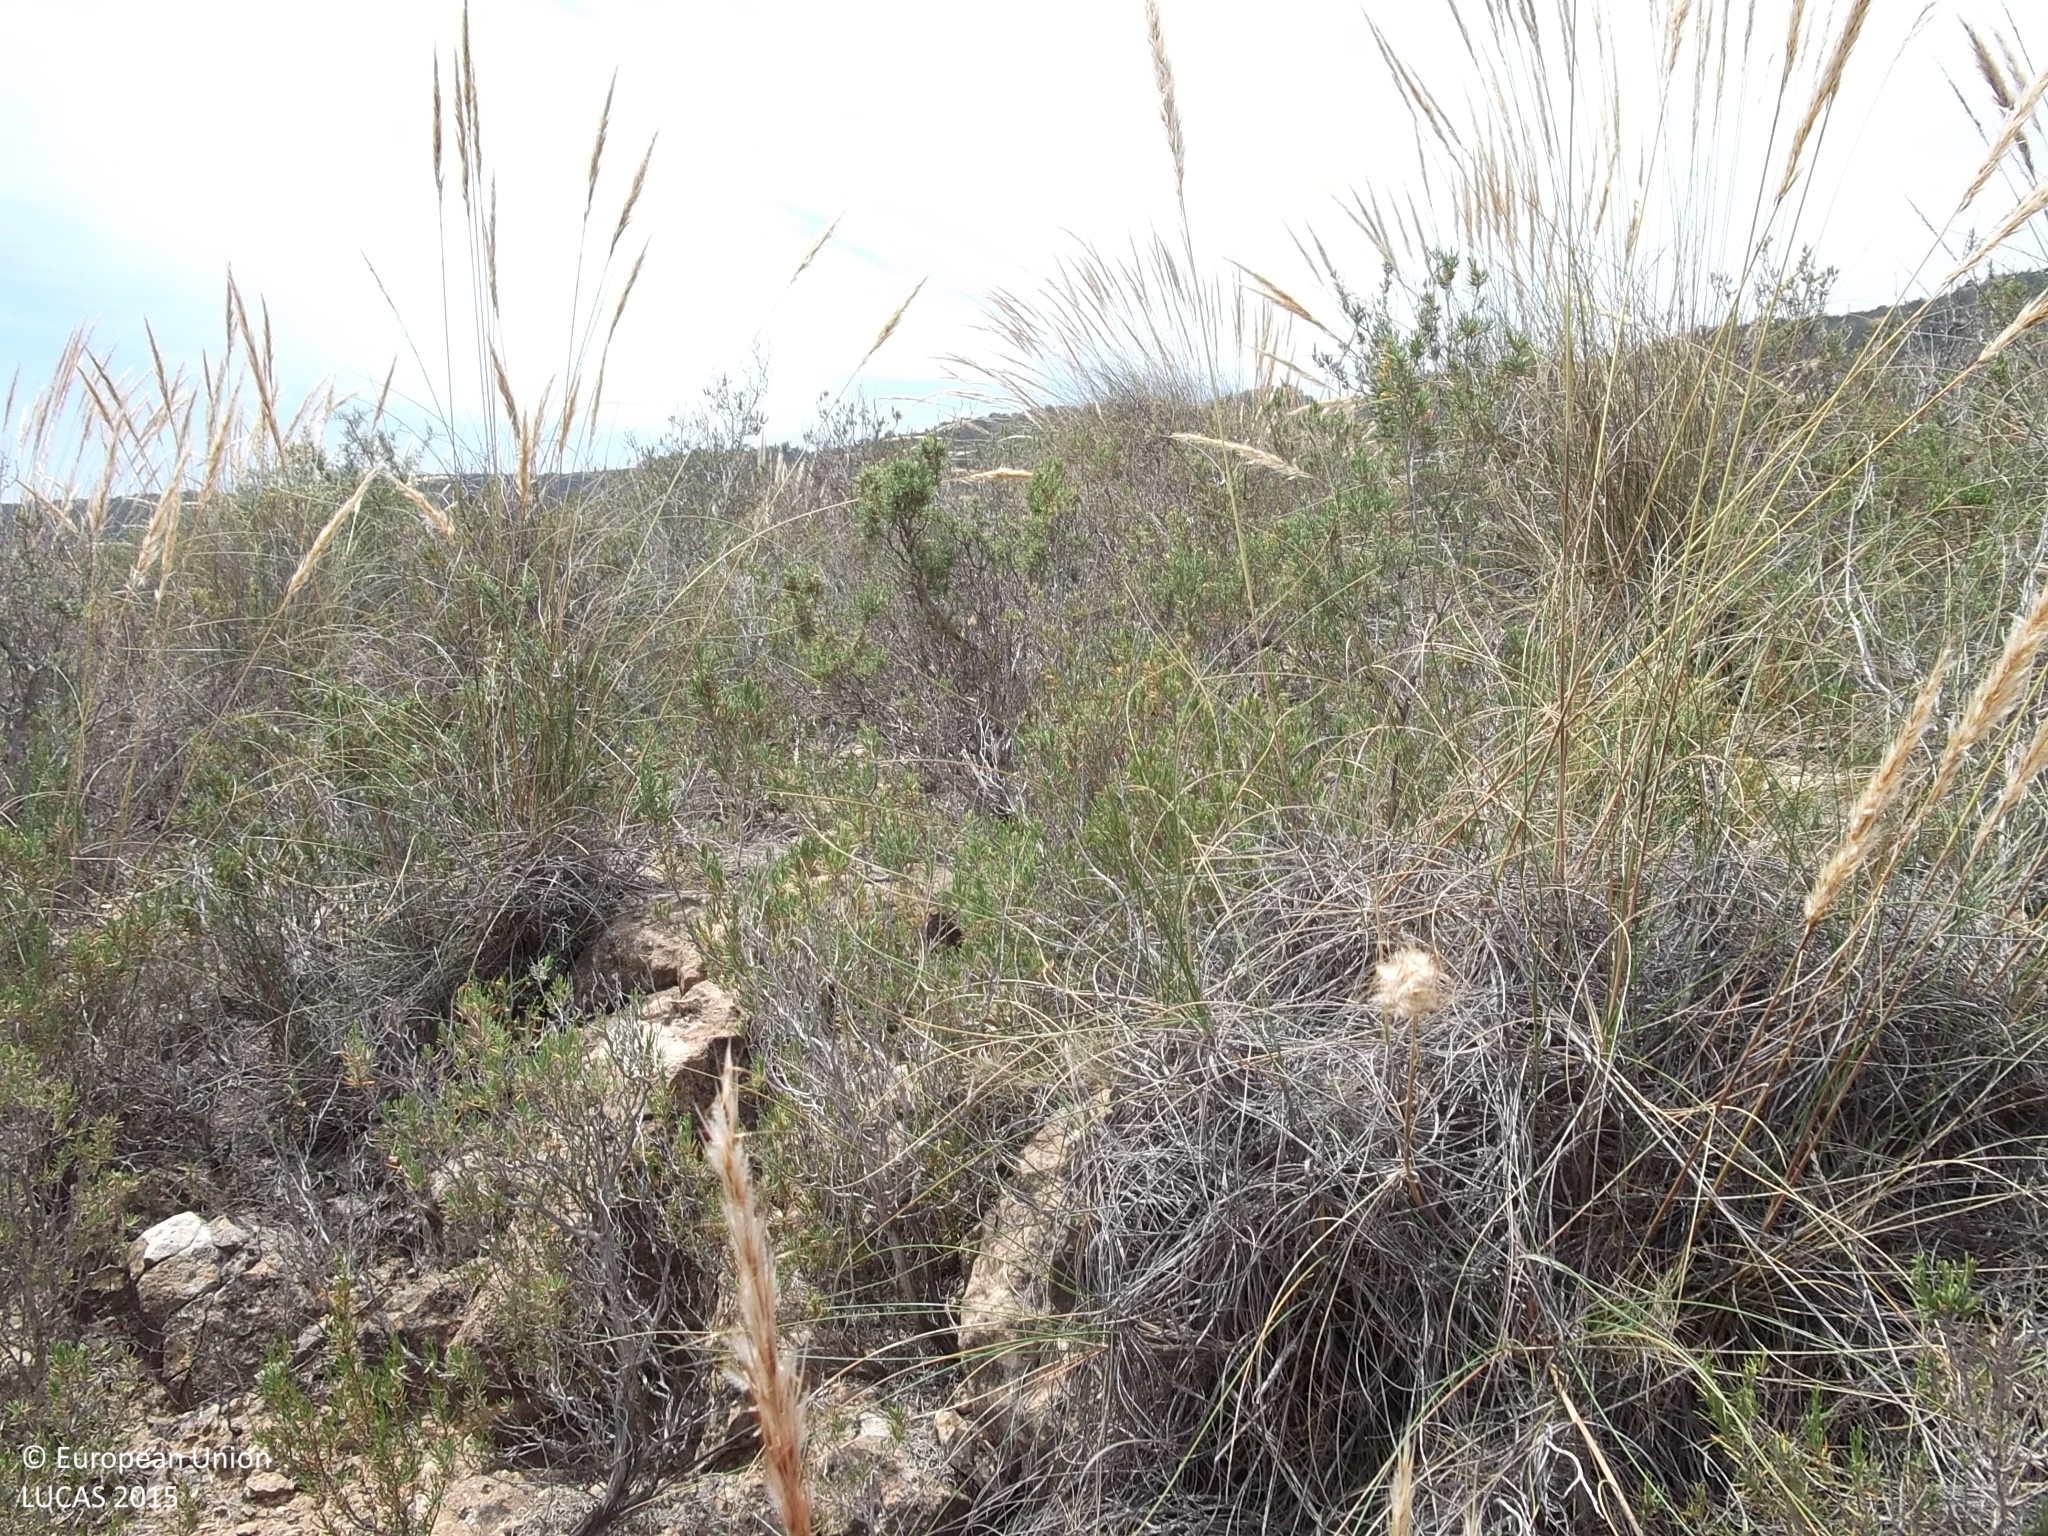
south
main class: Shrubland
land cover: Shrubland with sparse tree cover
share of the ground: 10 - 25 %
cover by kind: shrubs 45 %, herbaceous plants 30 %, consolidated bare surface 20 %, coniferous forest trees 5 %
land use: Semi-natural and natural areas not in use
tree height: > 5 m
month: May
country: ES
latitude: 37.9525
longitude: -0.9650
